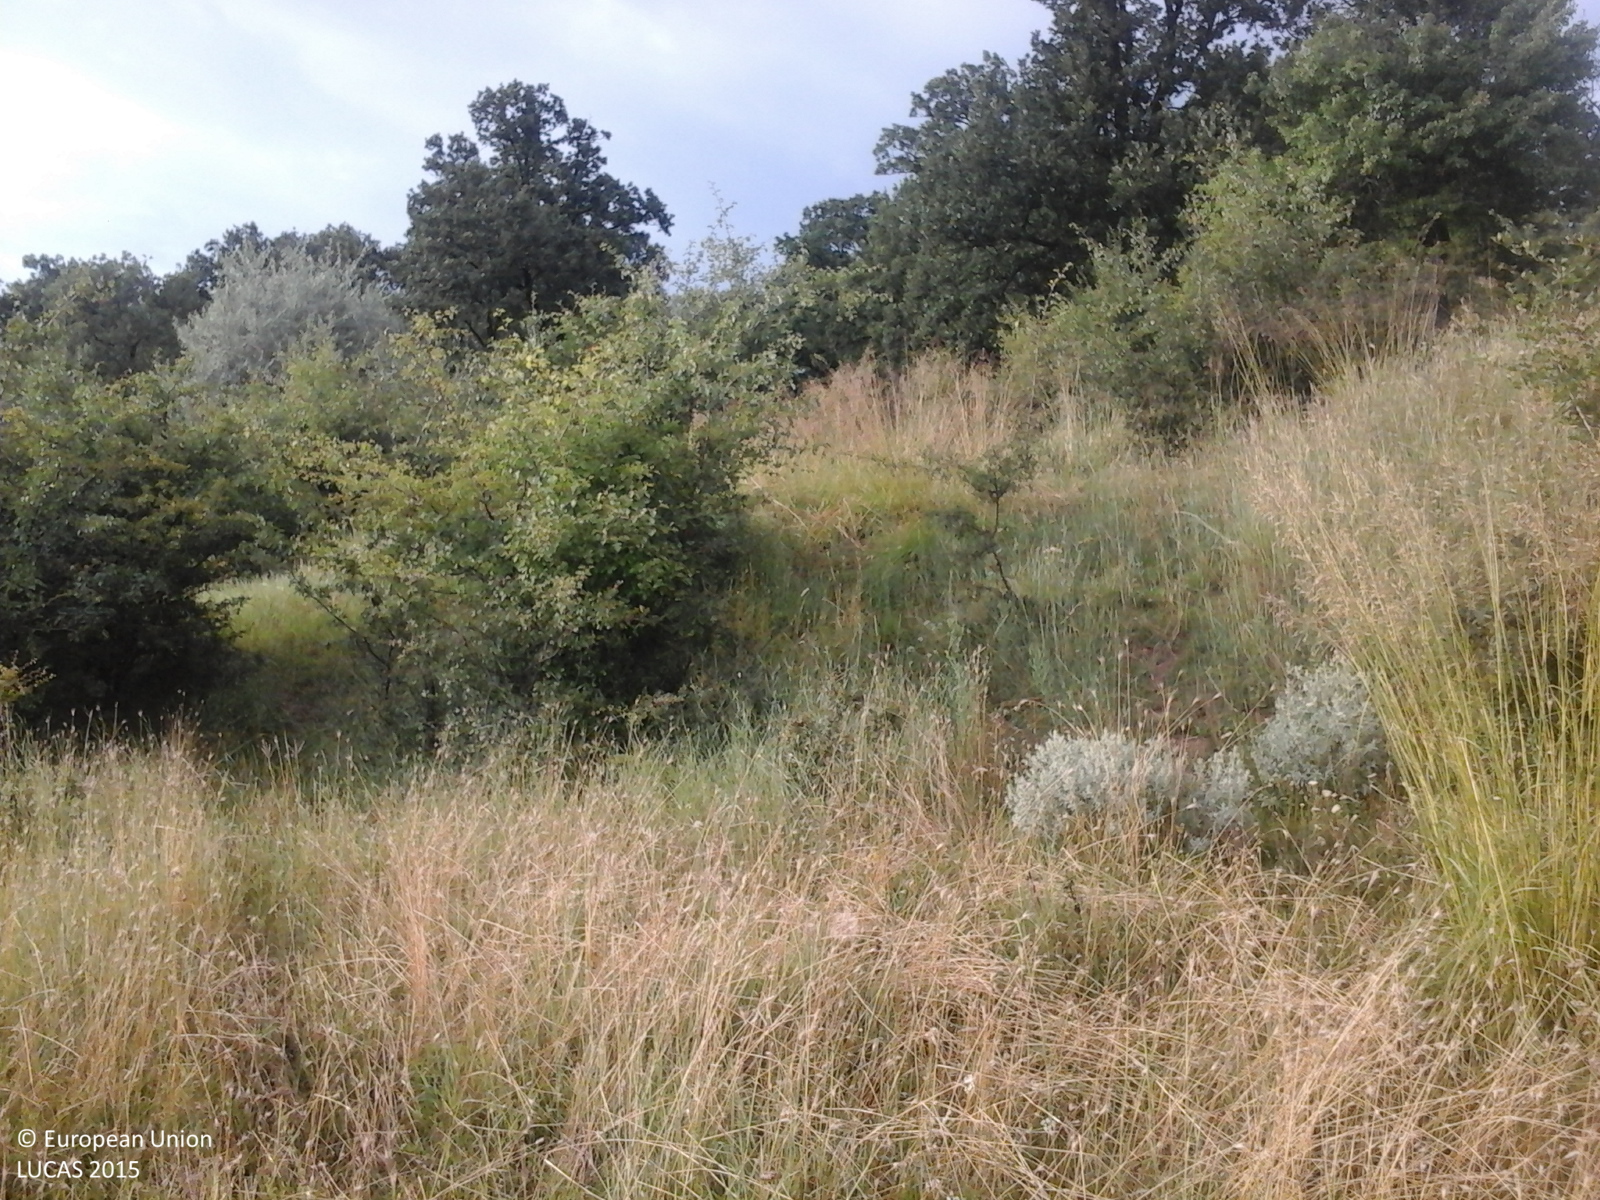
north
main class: Grassland
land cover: Grassland with sparse tree/shrub cover
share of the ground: > 75 %
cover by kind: herbaceous plants 85 %, shrubs 10 %, broadleaved forest trees 5 %
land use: Agriculture (excluding fallow land and kitchen gardens)
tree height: < 5 m
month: July
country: RO
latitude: 44.1166
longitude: 24.6016
